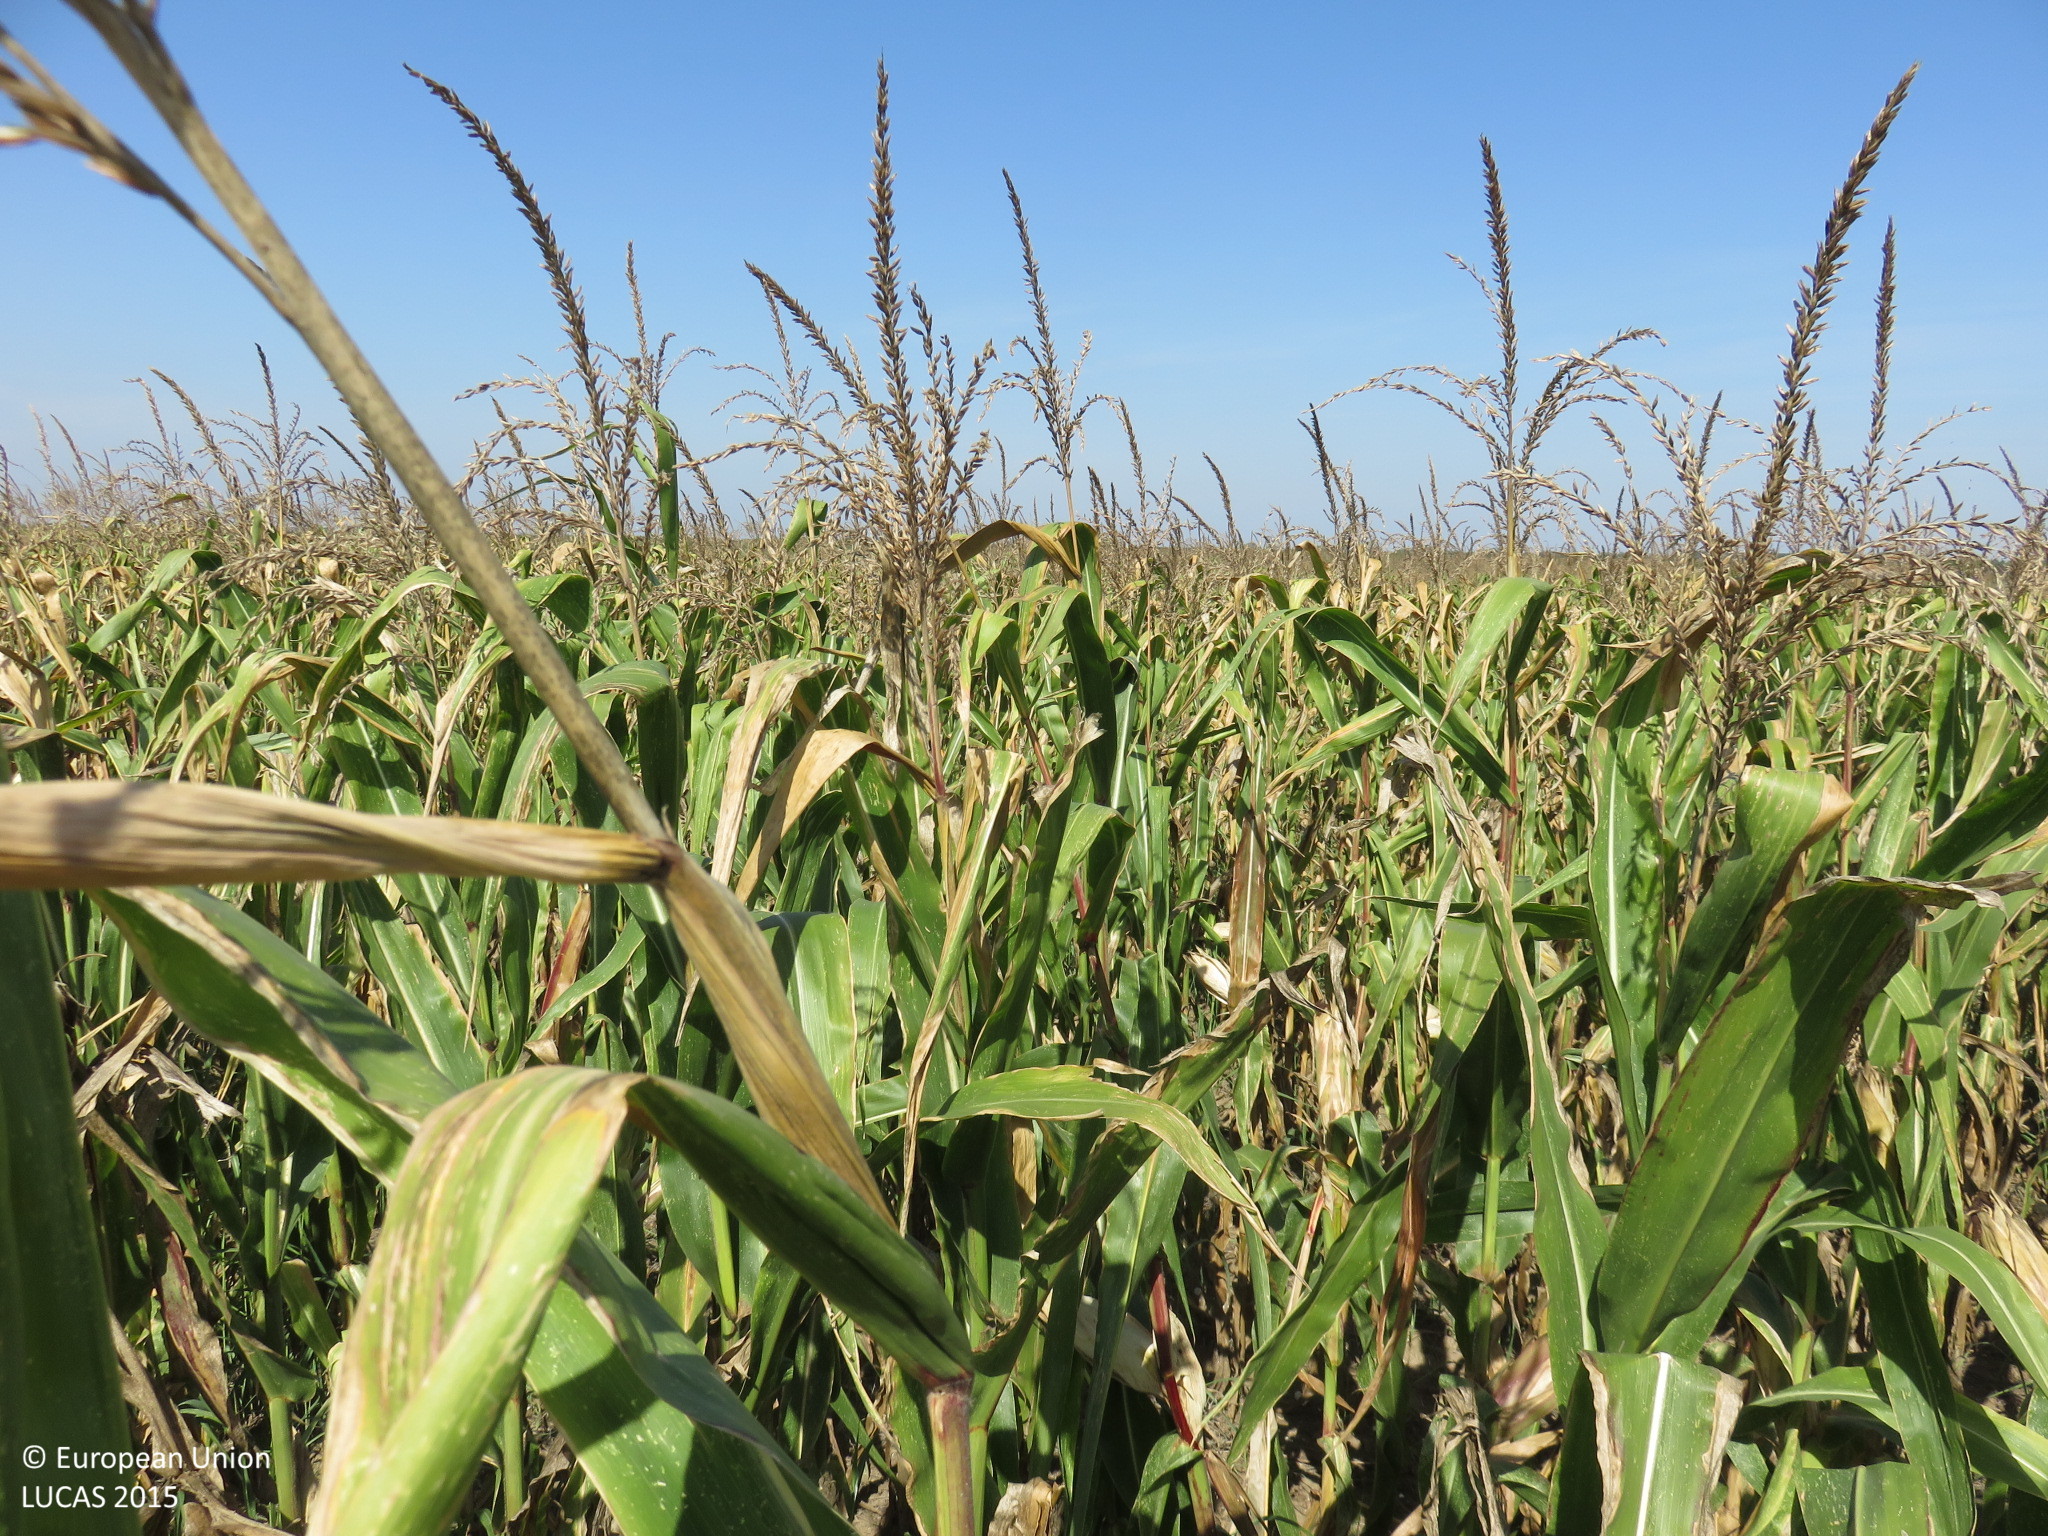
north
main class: Cropland
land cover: Maize
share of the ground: > 75 %
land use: Agriculture (excluding fallow land and kitchen gardens)
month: September
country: BG
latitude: 43.6896
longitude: 24.6437
